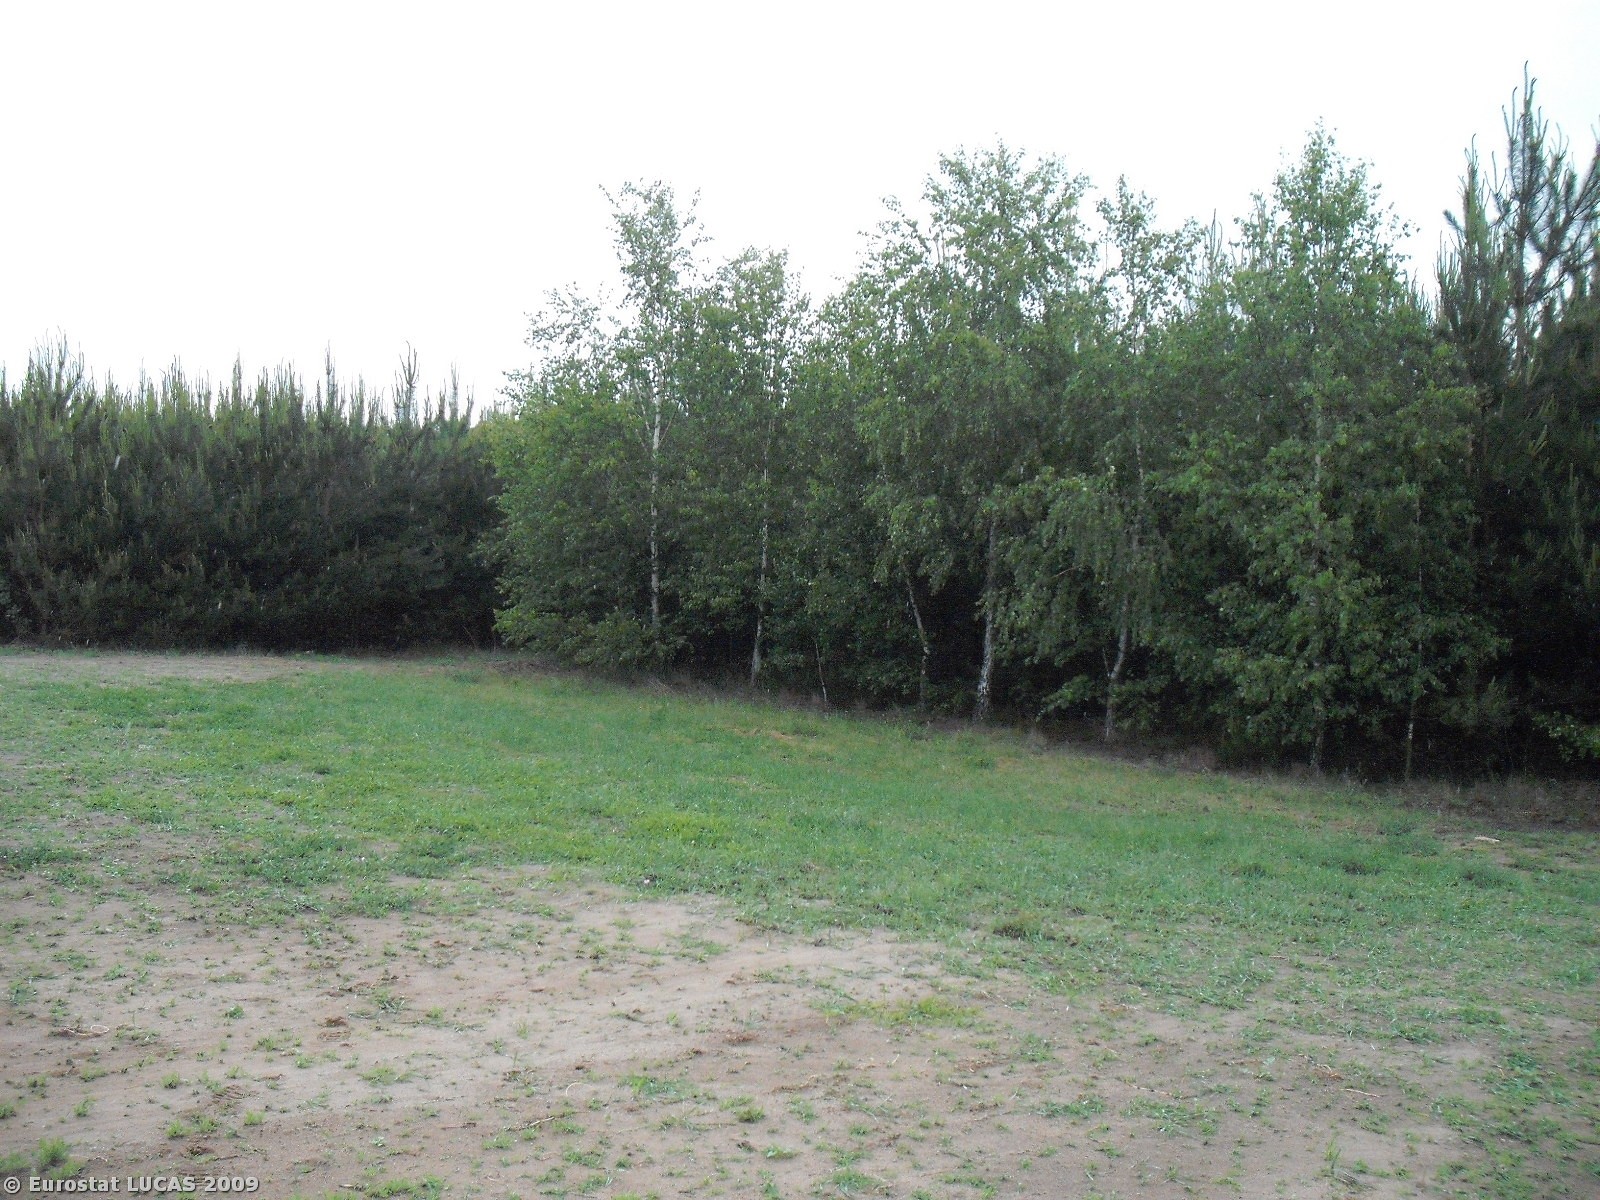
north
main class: Grassland
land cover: Grassland without tree/shrub cover
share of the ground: < 10 %
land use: Agriculture (excluding fallow land and kitchen gardens)
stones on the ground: < 10 %
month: May
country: PL
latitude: 51.0552
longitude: 19.9188
